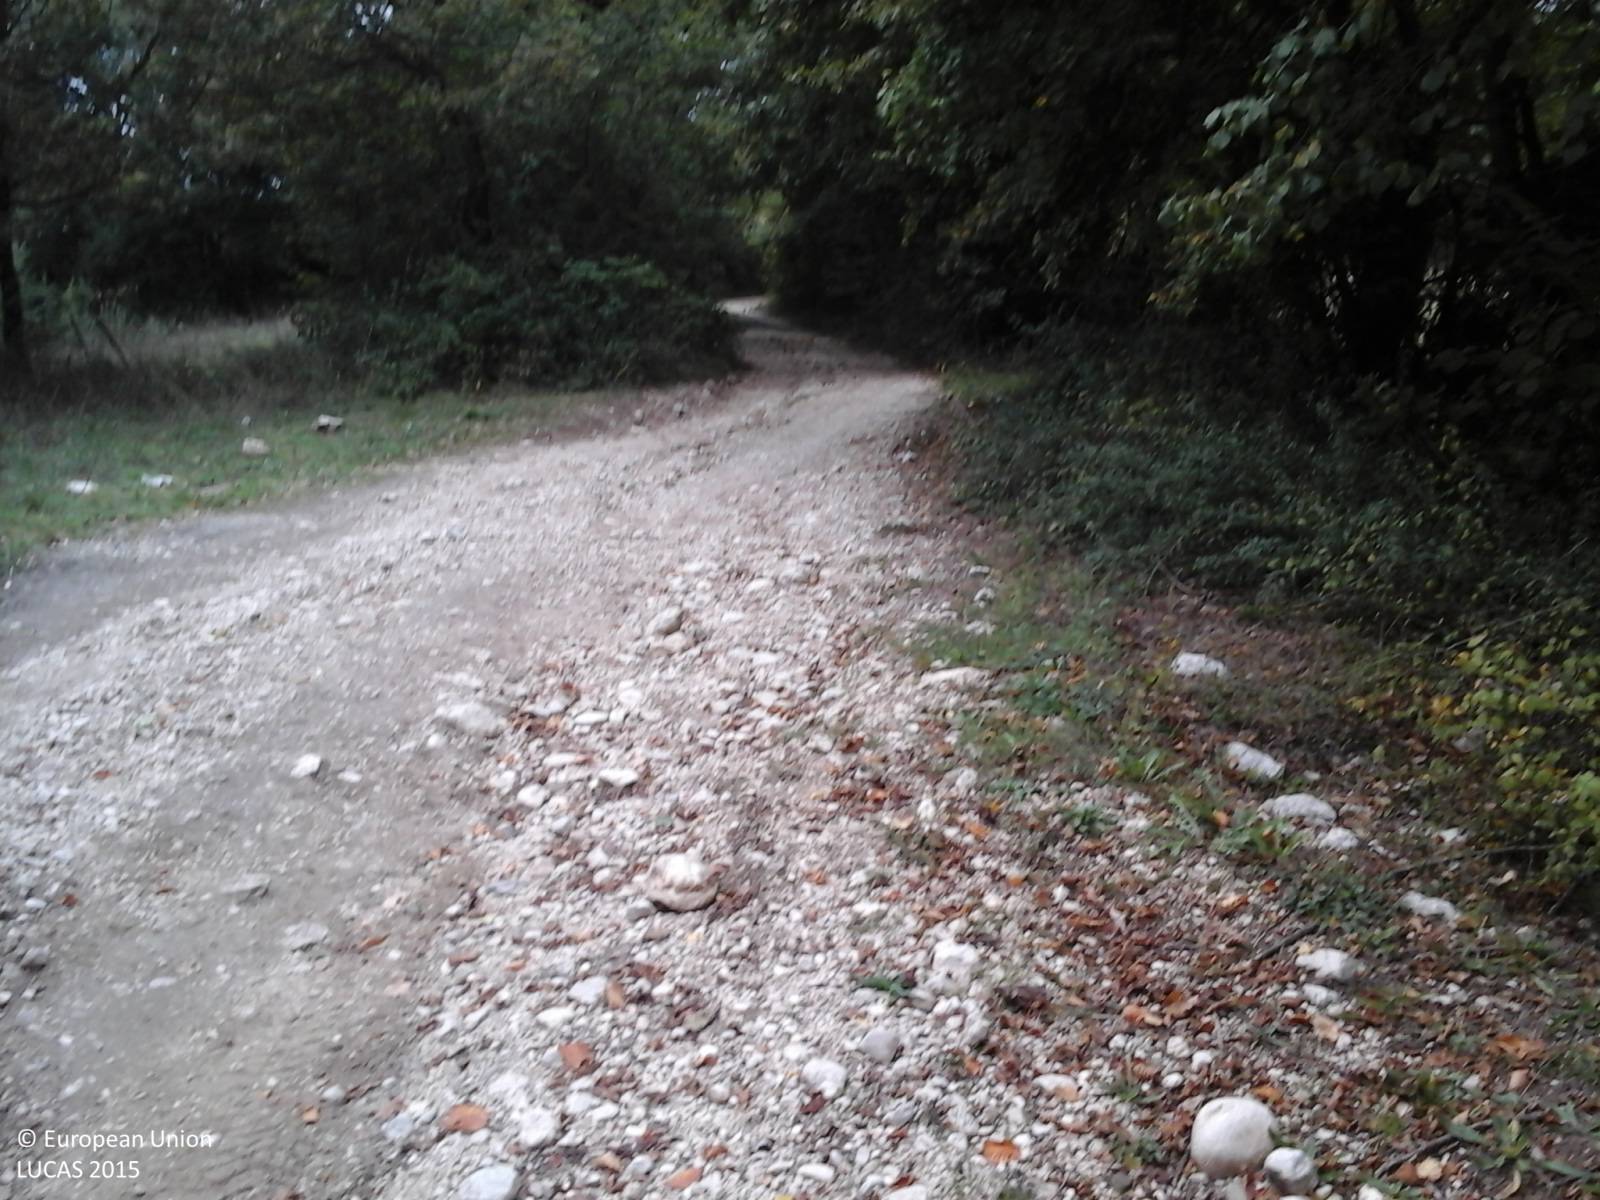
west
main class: Grassland
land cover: Grassland without tree/shrub cover
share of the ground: > 75 %
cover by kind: herbaceous plants 100 %
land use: Agriculture (excluding fallow land and kitchen gardens)
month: October
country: IT
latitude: 42.2608
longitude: 13.1776
